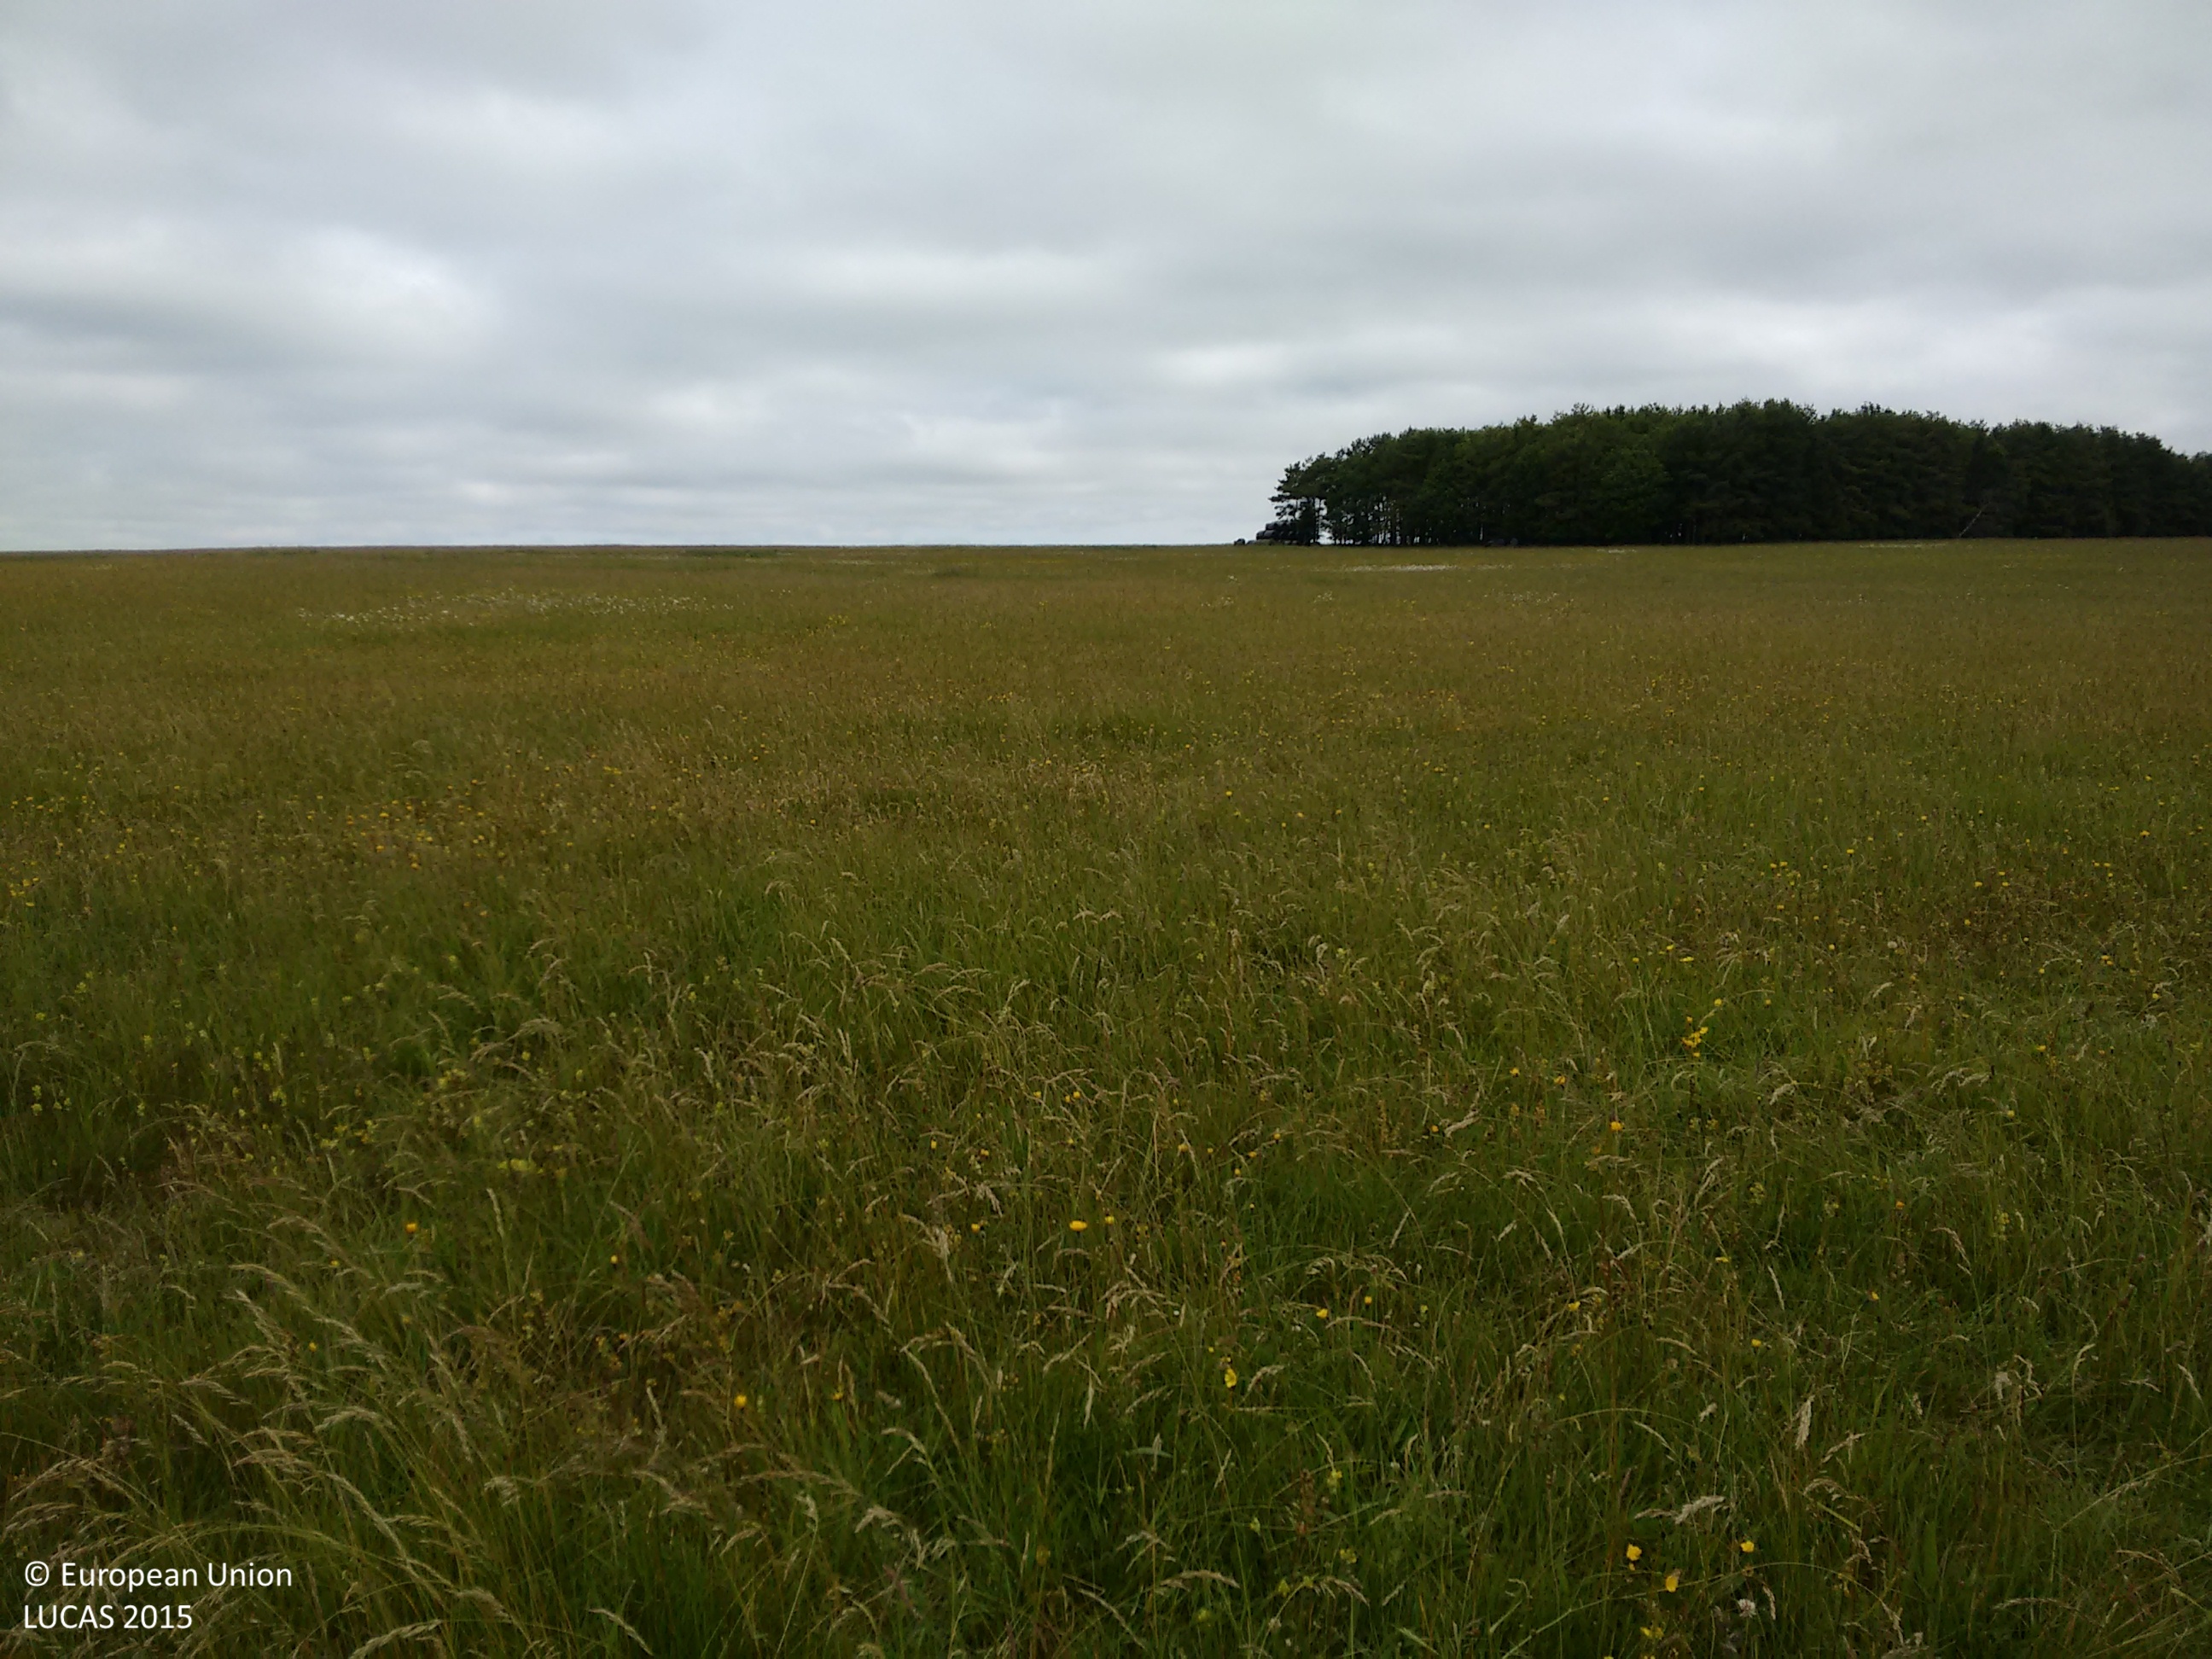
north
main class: Grassland
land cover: Grassland without tree/shrub cover
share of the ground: > 75 %
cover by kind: herbaceous plants 100 %
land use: Community services
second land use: Agriculture (excluding fallow land and kitchen gardens)
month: June
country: GB
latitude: 51.2750
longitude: -1.8247
